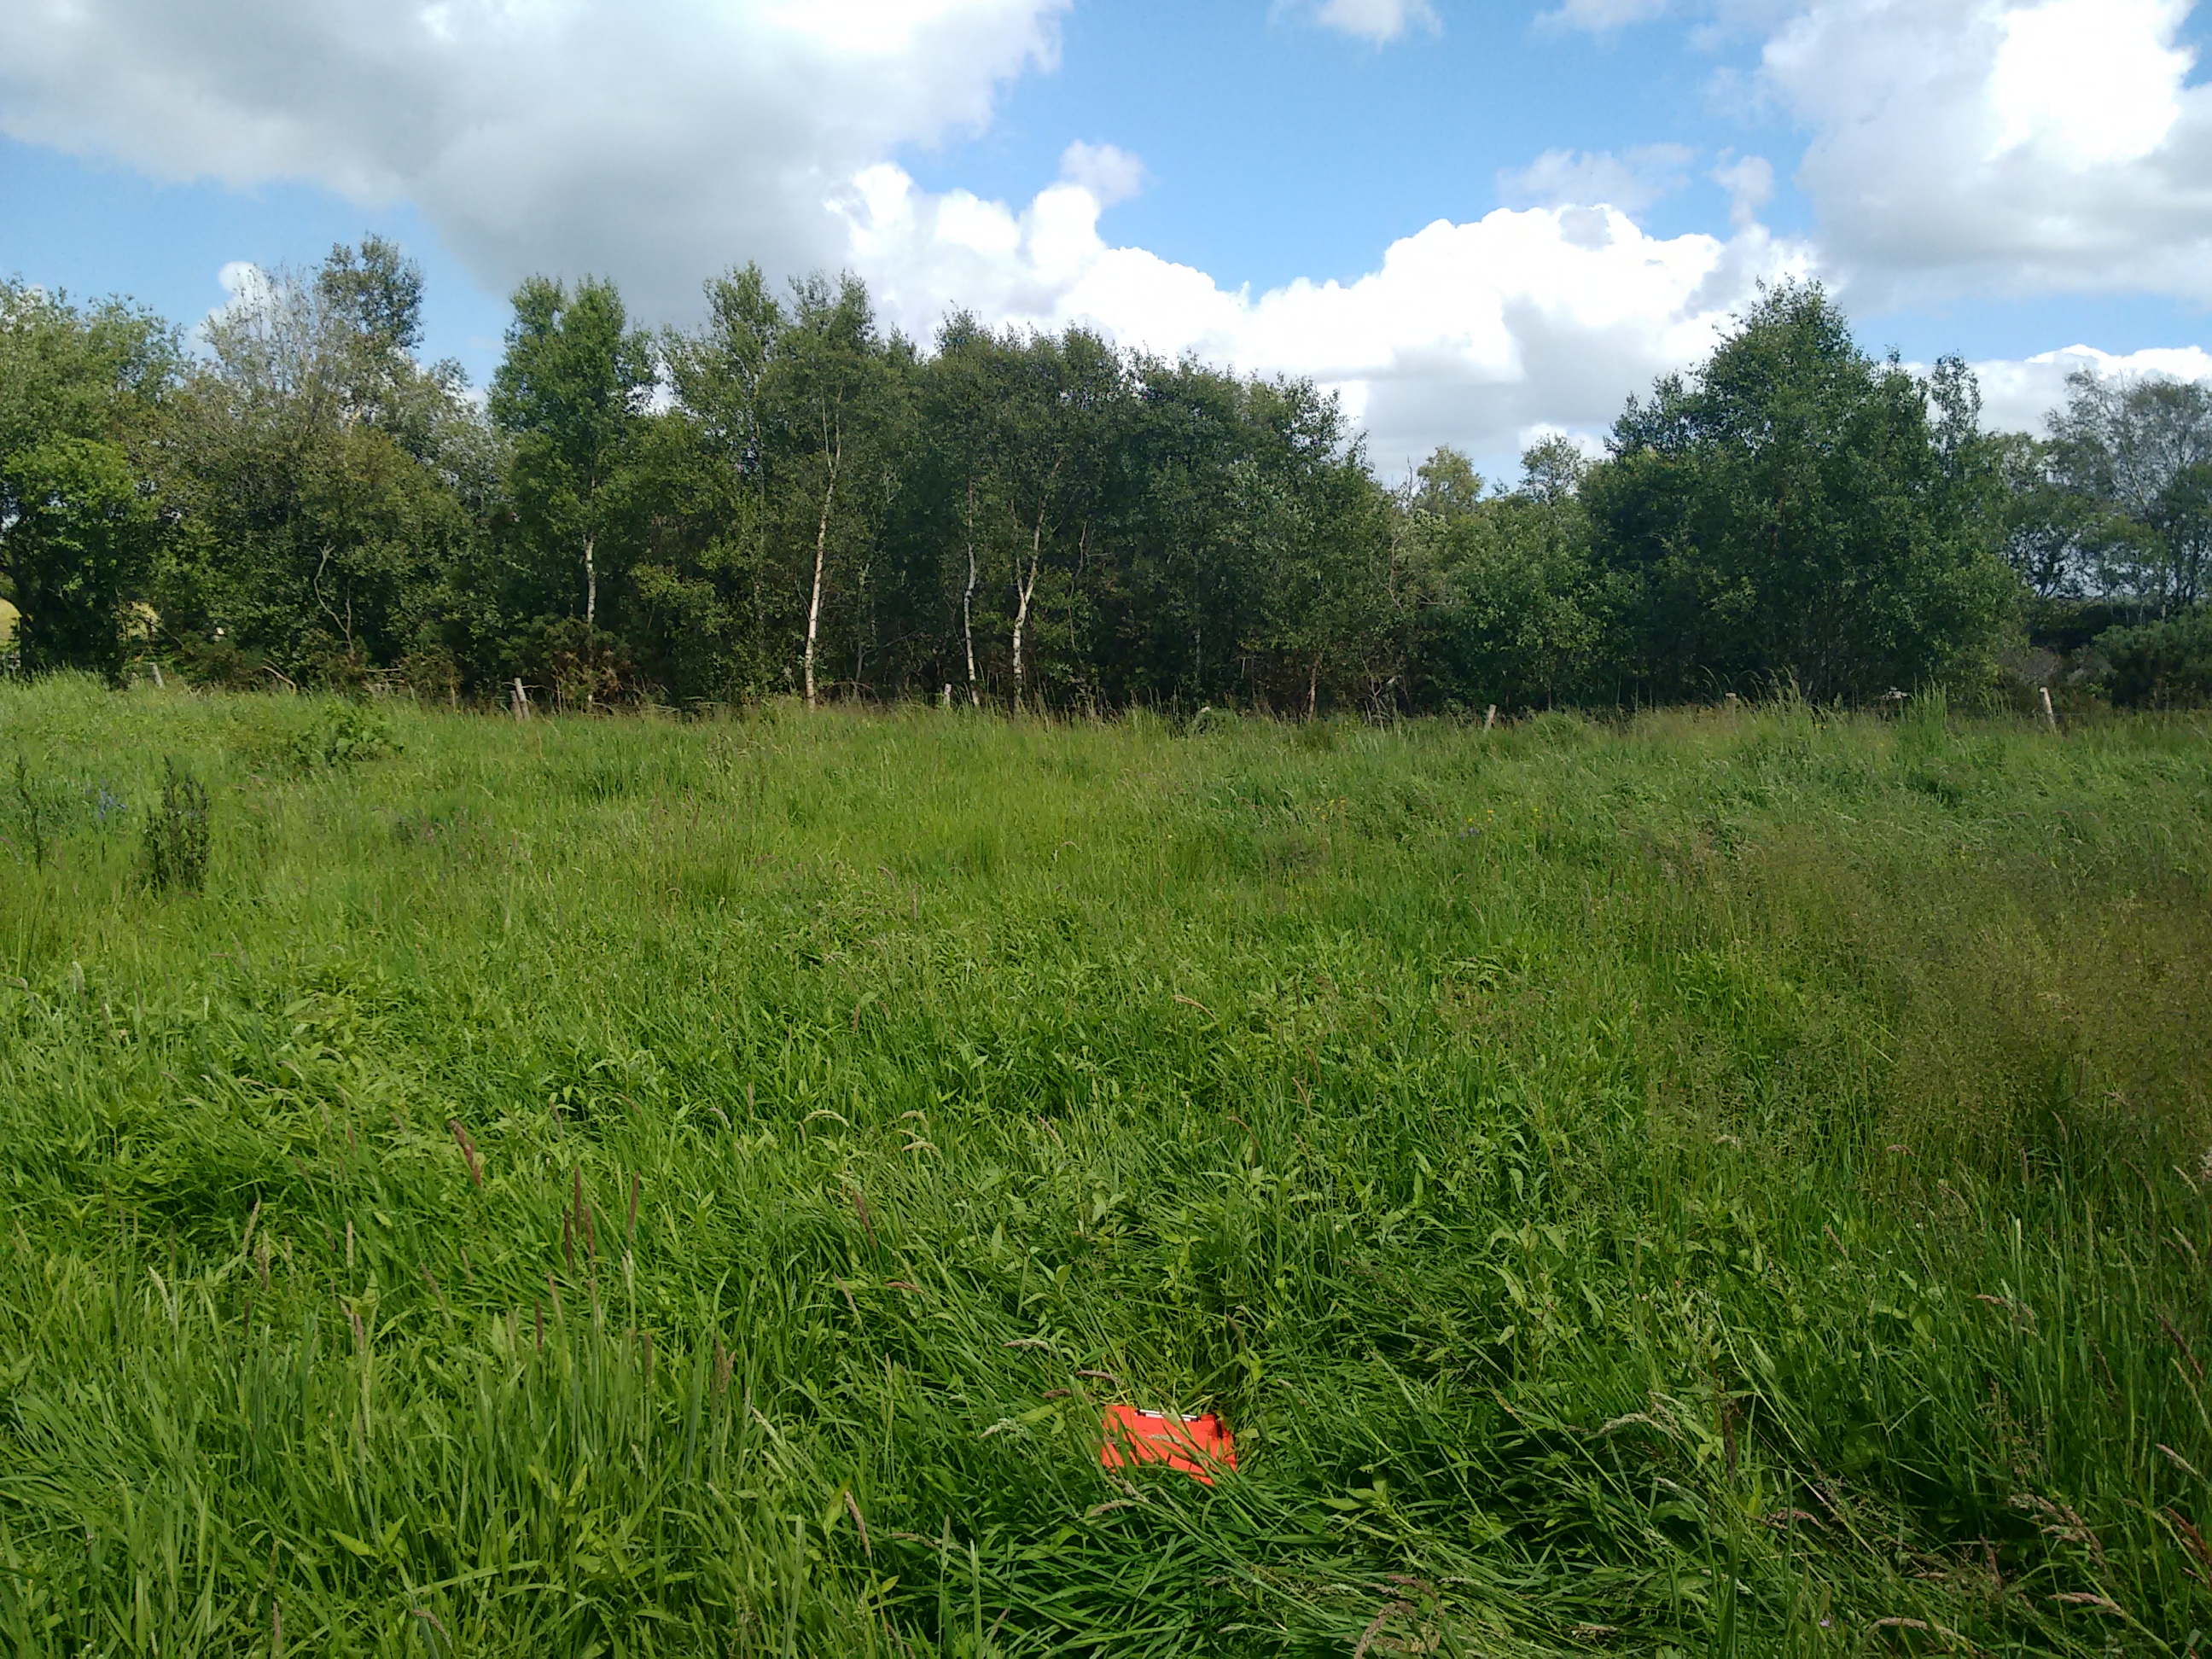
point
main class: Grassland
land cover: Grassland without tree/shrub cover
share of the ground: > 75 %
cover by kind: herbaceous plants 95 %, consolidated bare surface 5 %
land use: Agriculture (excluding fallow land and kitchen gardens)
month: June
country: IE
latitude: 53.3417
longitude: -7.9102
